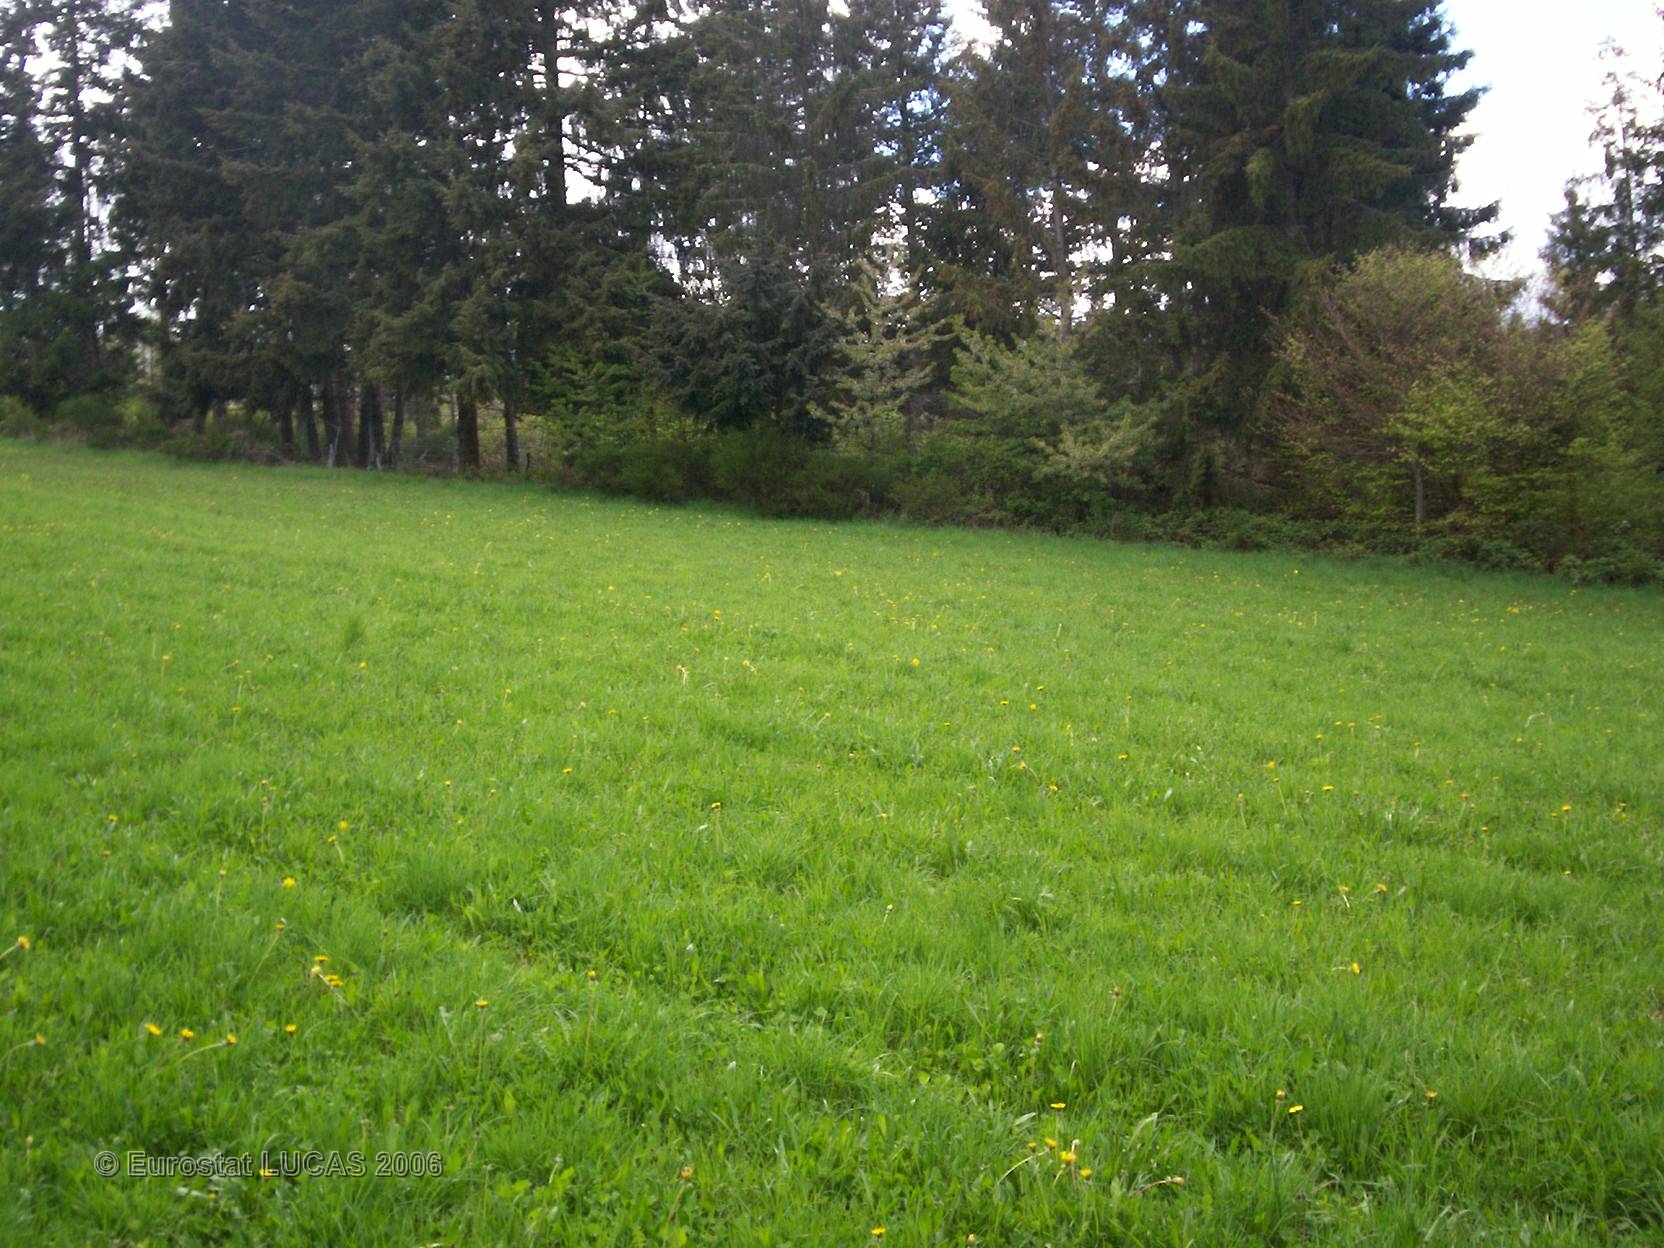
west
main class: Grassland
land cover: Grassland without tree/shrub cover
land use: Agriculture (excluding fallow land and kitchen gardens)
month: May
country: FR
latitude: 45.1664
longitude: 3.3230
